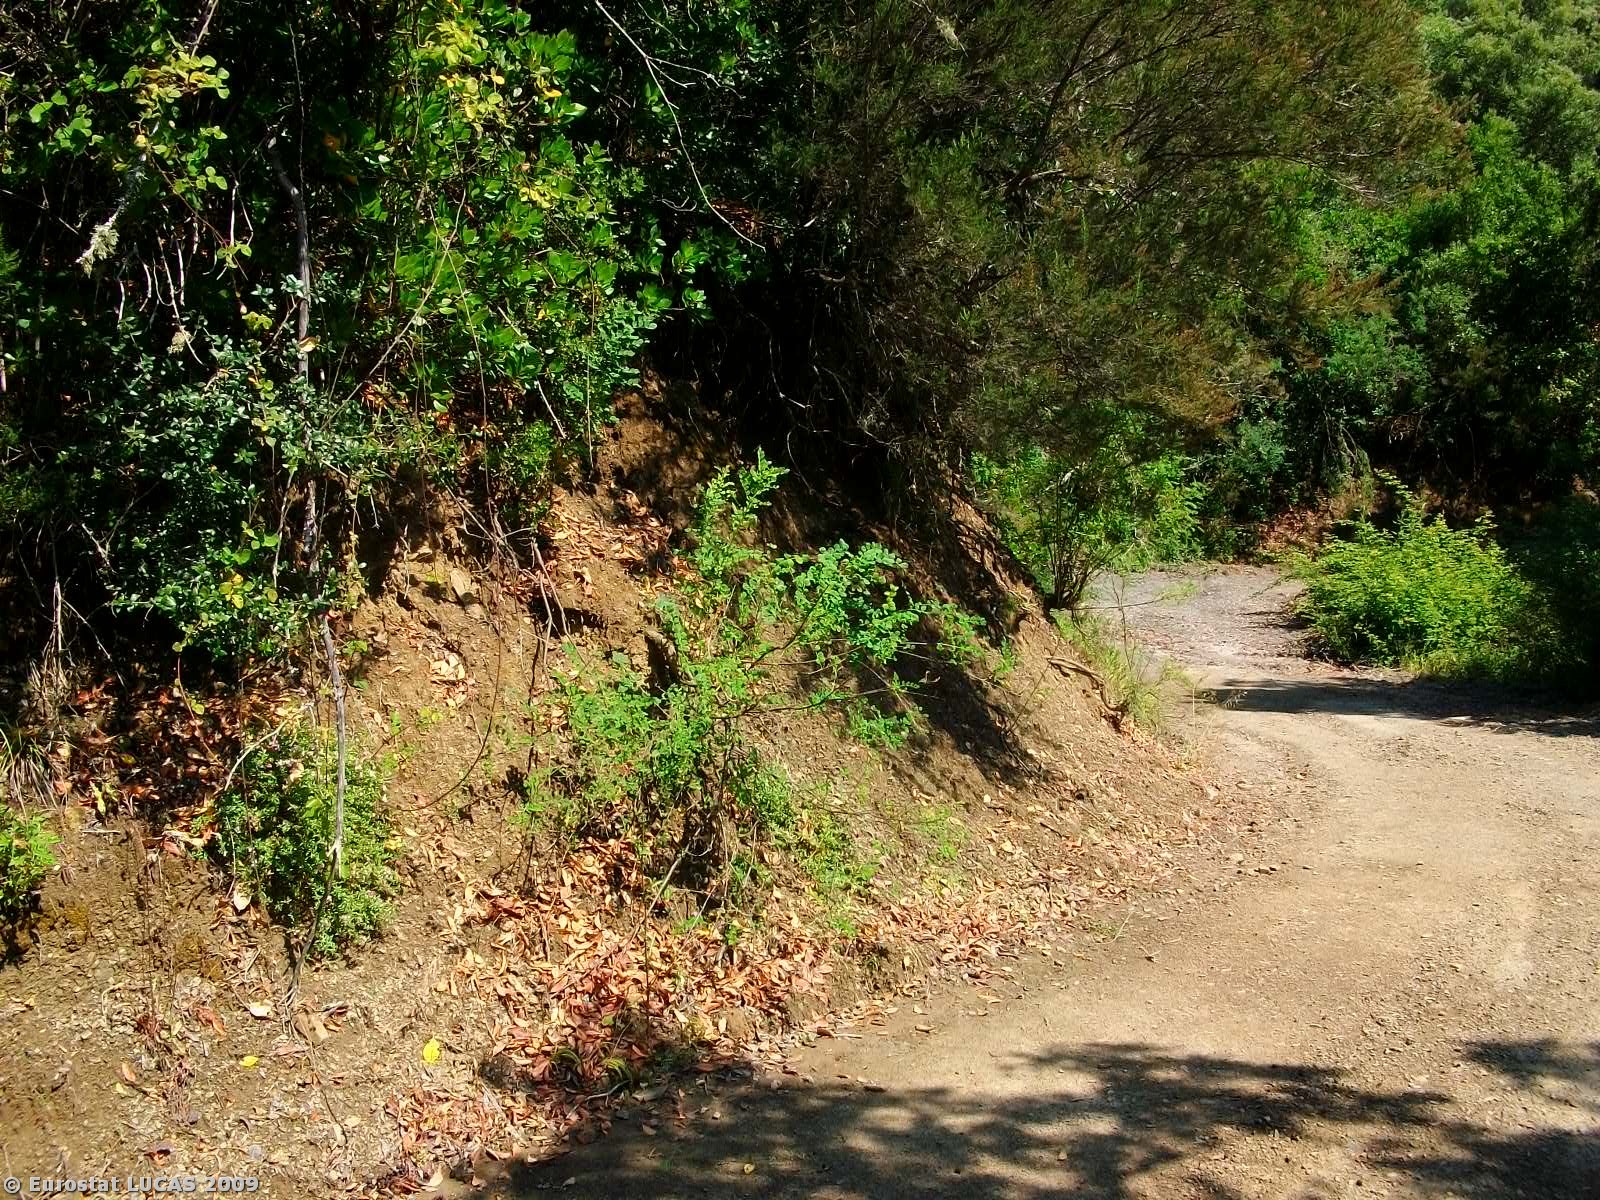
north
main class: Woodland
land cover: Mixed woodland
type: broadleaved evergreen forest
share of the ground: > 75 %
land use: Forestry
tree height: > 5 m
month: June
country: GR
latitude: 38.7882
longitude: 21.4733
